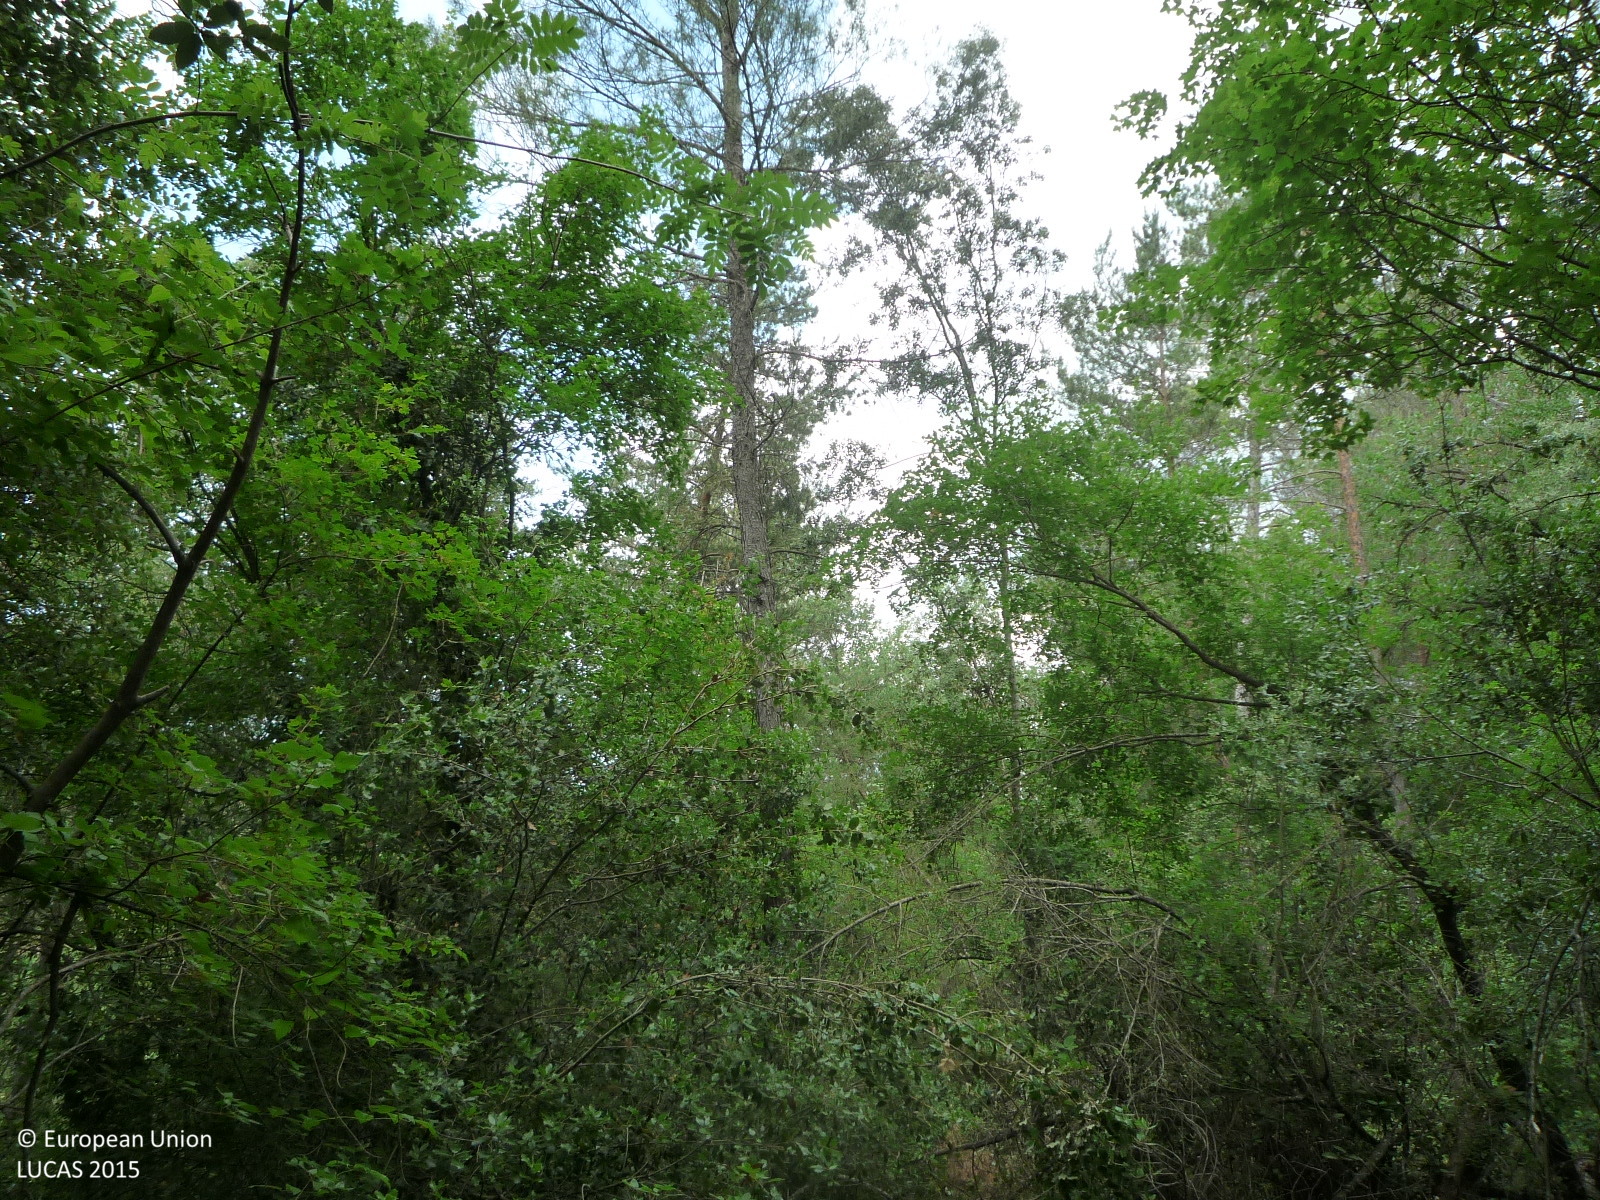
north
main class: Woodland
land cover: Pine dominated mixed woodland
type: coniferous forest of the mediterranean region
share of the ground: > 75 %
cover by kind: coniferous forest trees 60 %, broadleaved forest trees 40 %
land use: Forestry
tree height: > 5 m
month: June
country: ES
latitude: 41.8118
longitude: 2.0102
